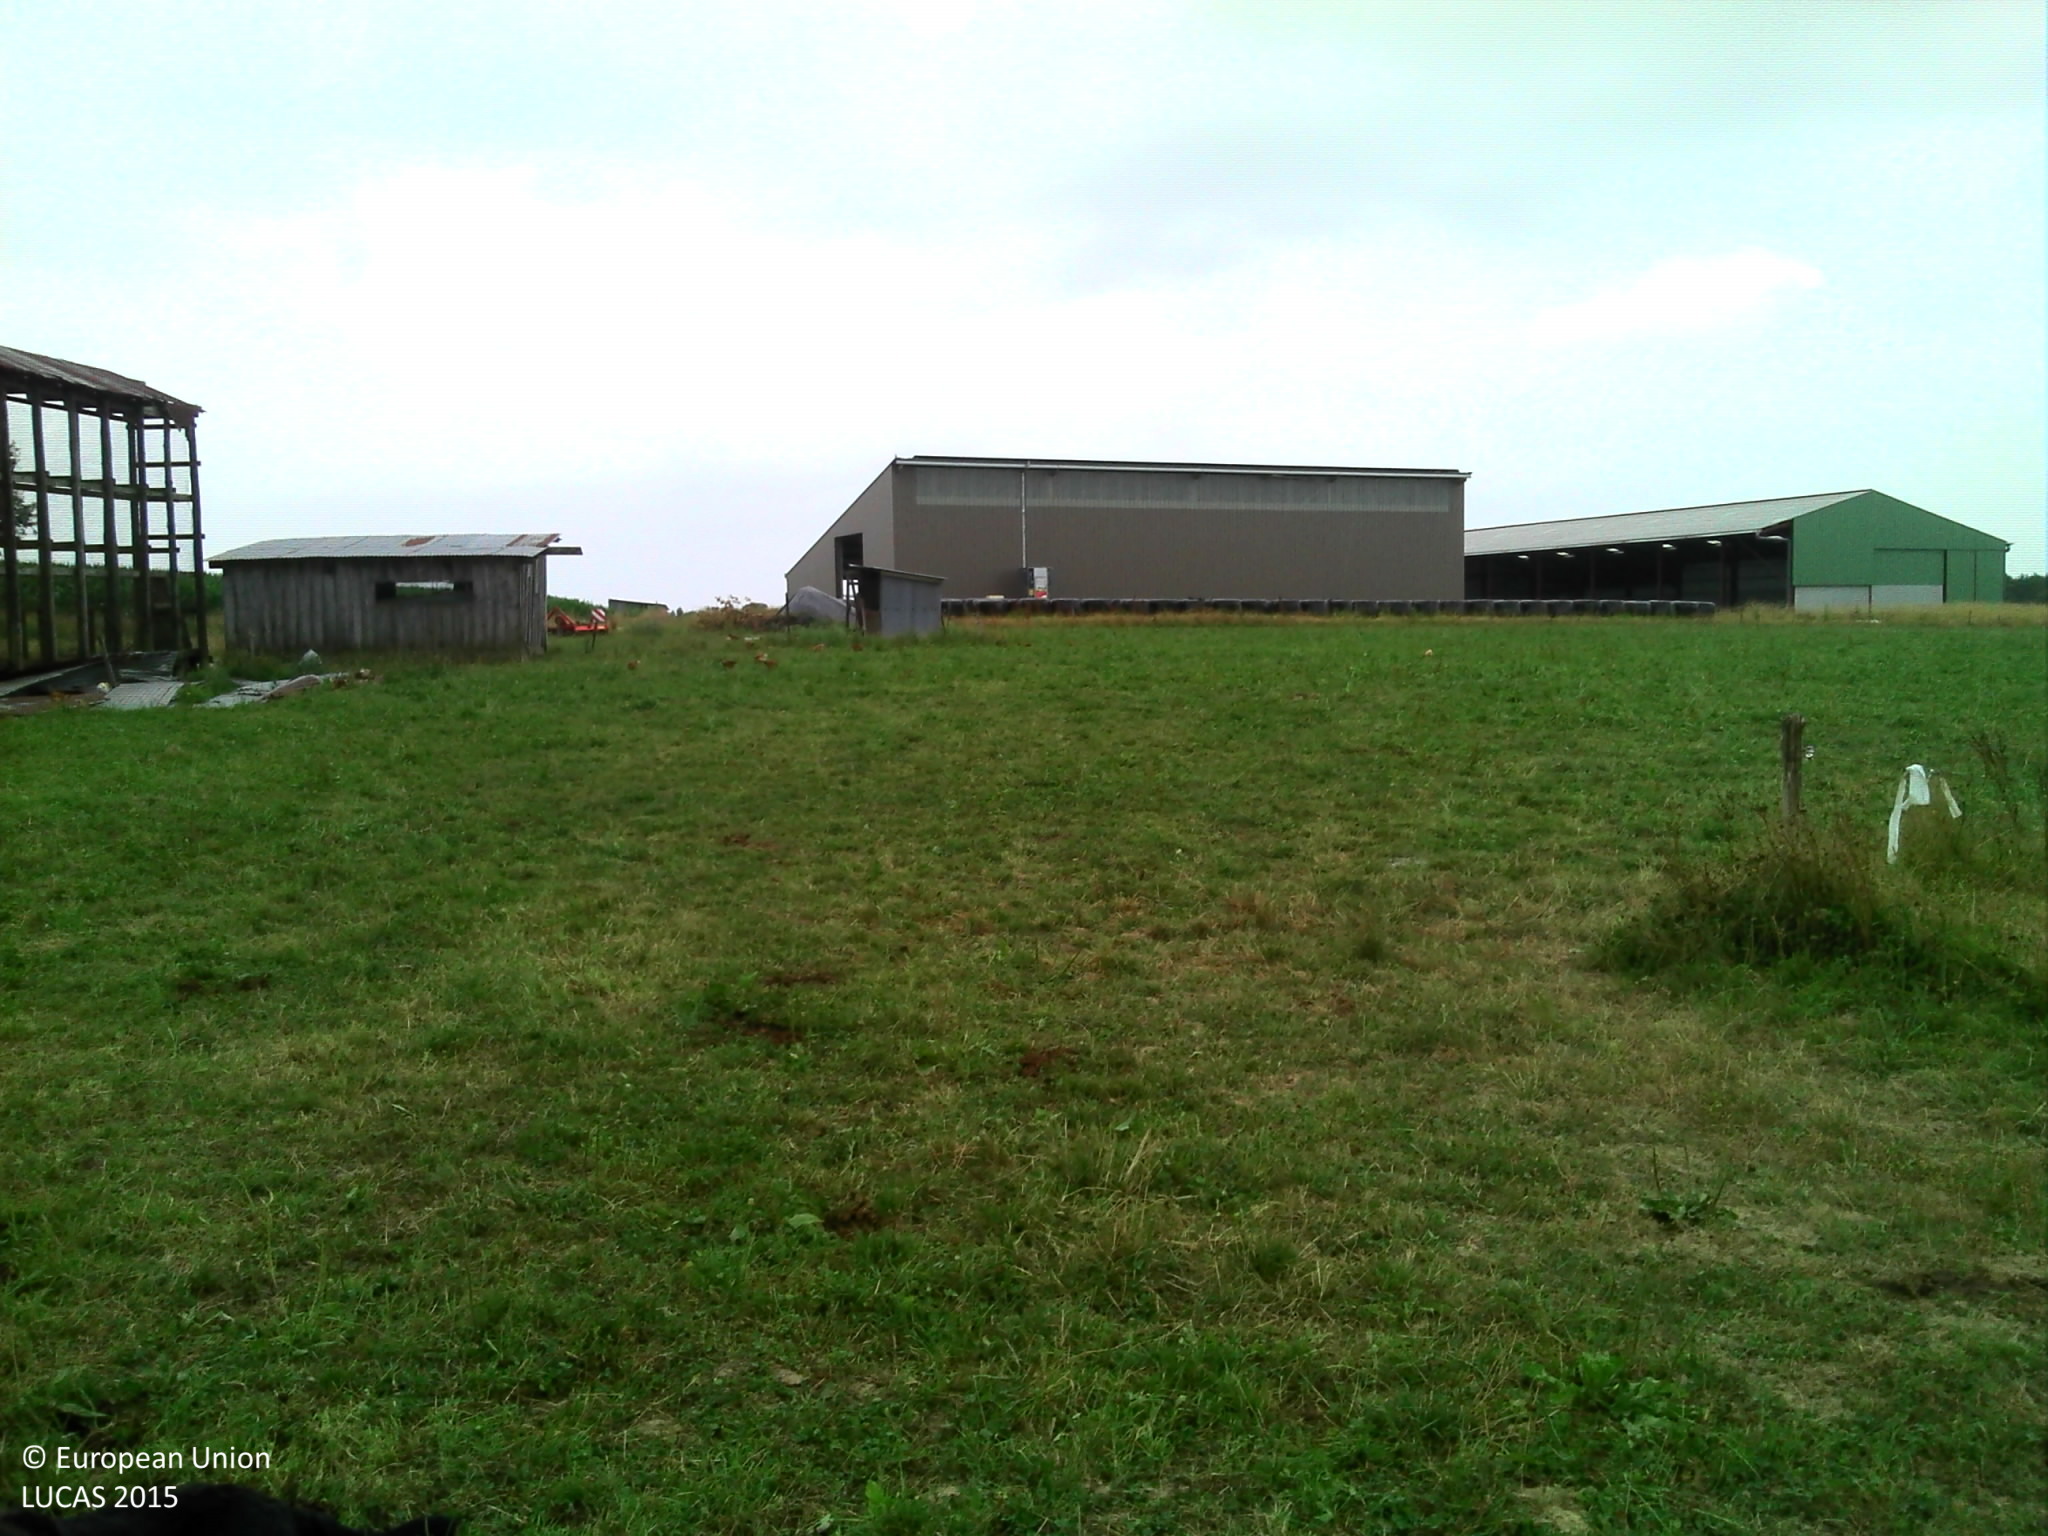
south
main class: Grassland
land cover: Grassland without tree/shrub cover
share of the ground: > 75 %
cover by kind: herbaceous plants 90 %, unconsolidated bare surface 10 %
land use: Agriculture (excluding fallow land and kitchen gardens)
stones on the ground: < 10 %
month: July
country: FR
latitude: 43.6375
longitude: -1.1599
